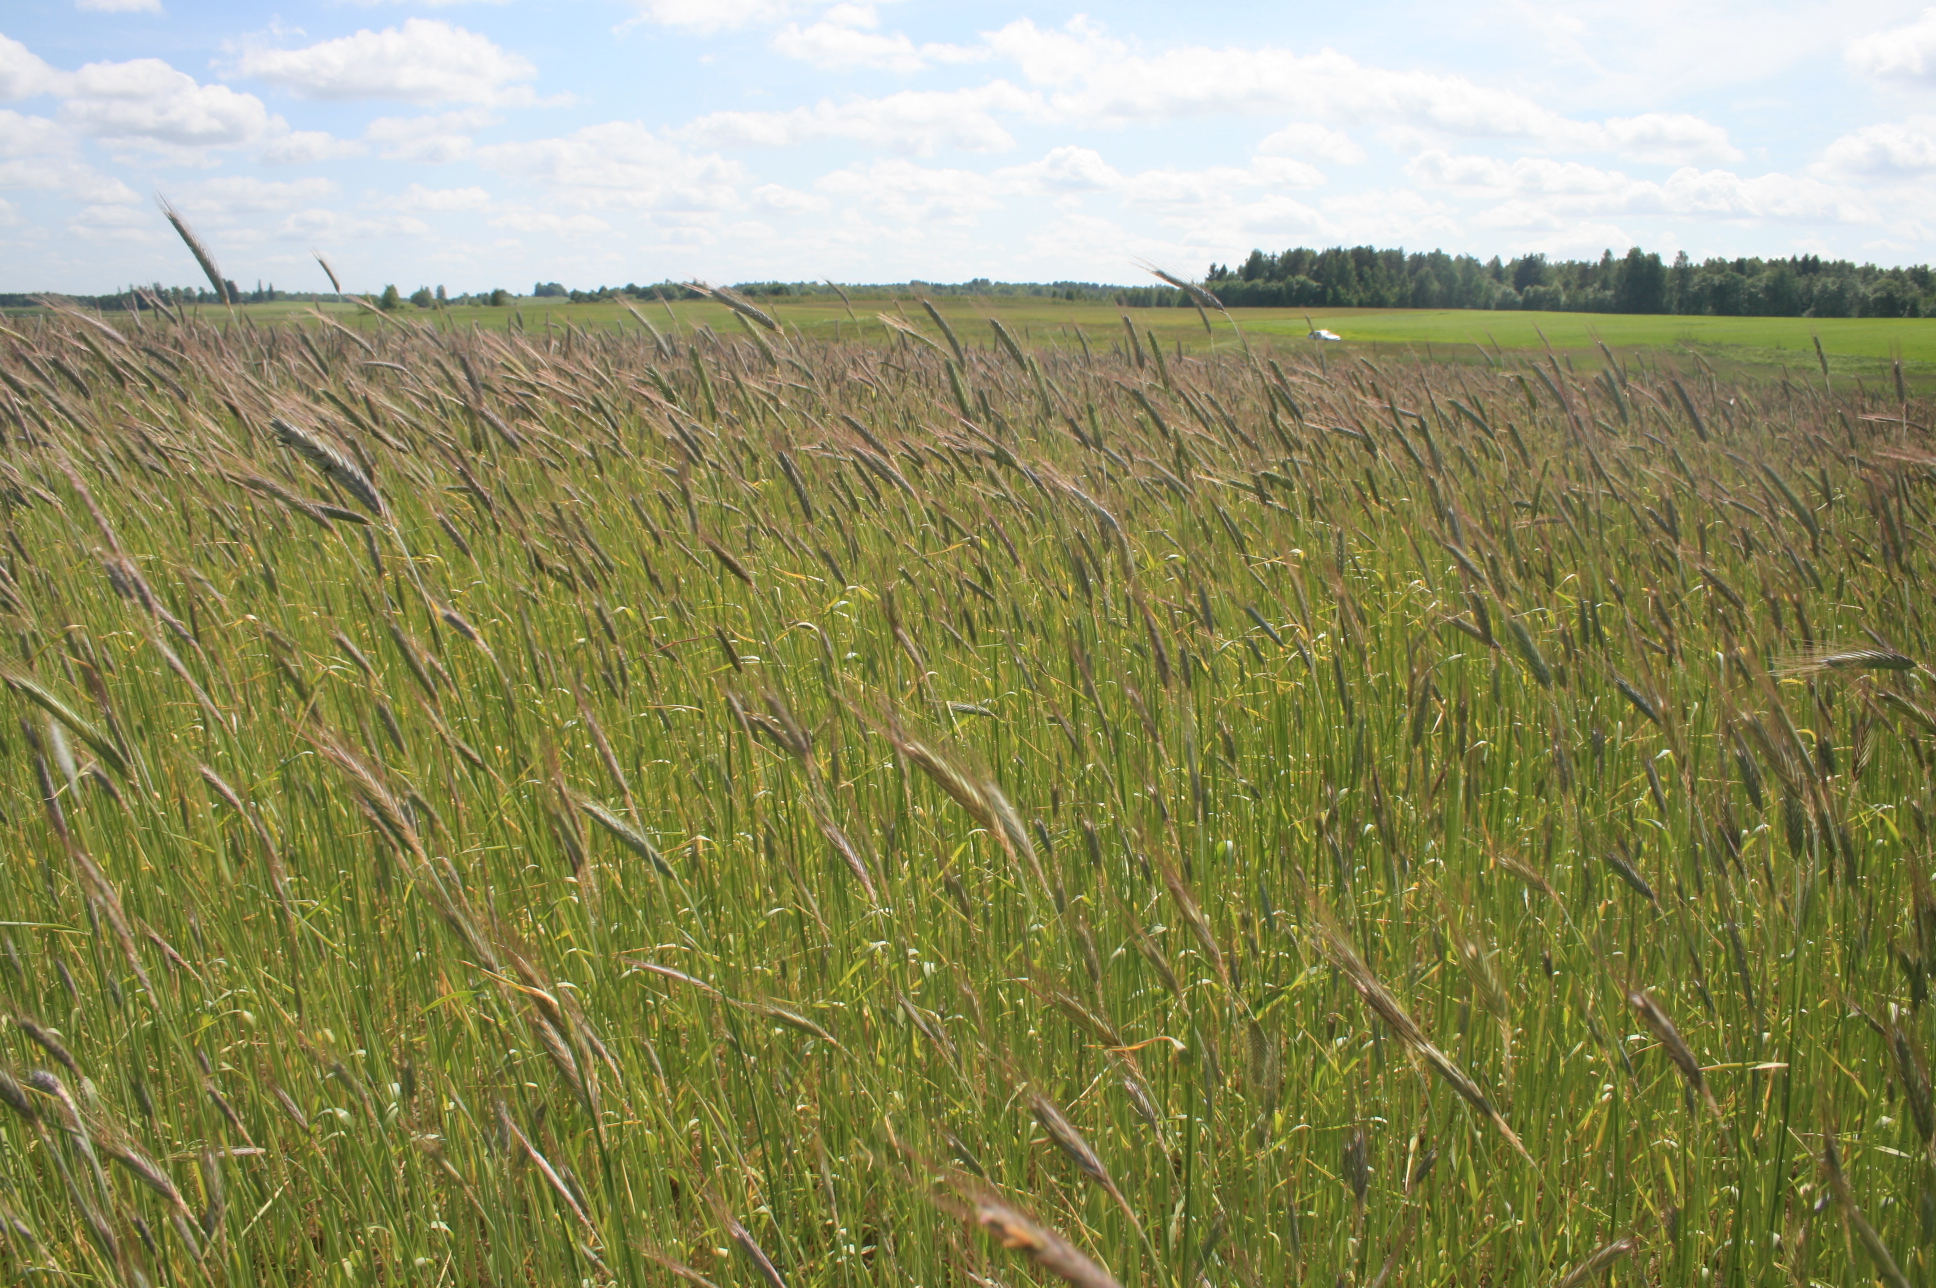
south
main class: Cropland
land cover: Rye
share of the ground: > 75 %
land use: Agriculture (excluding fallow land and kitchen gardens)
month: June
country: LT
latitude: 55.7561
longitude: 22.3106
